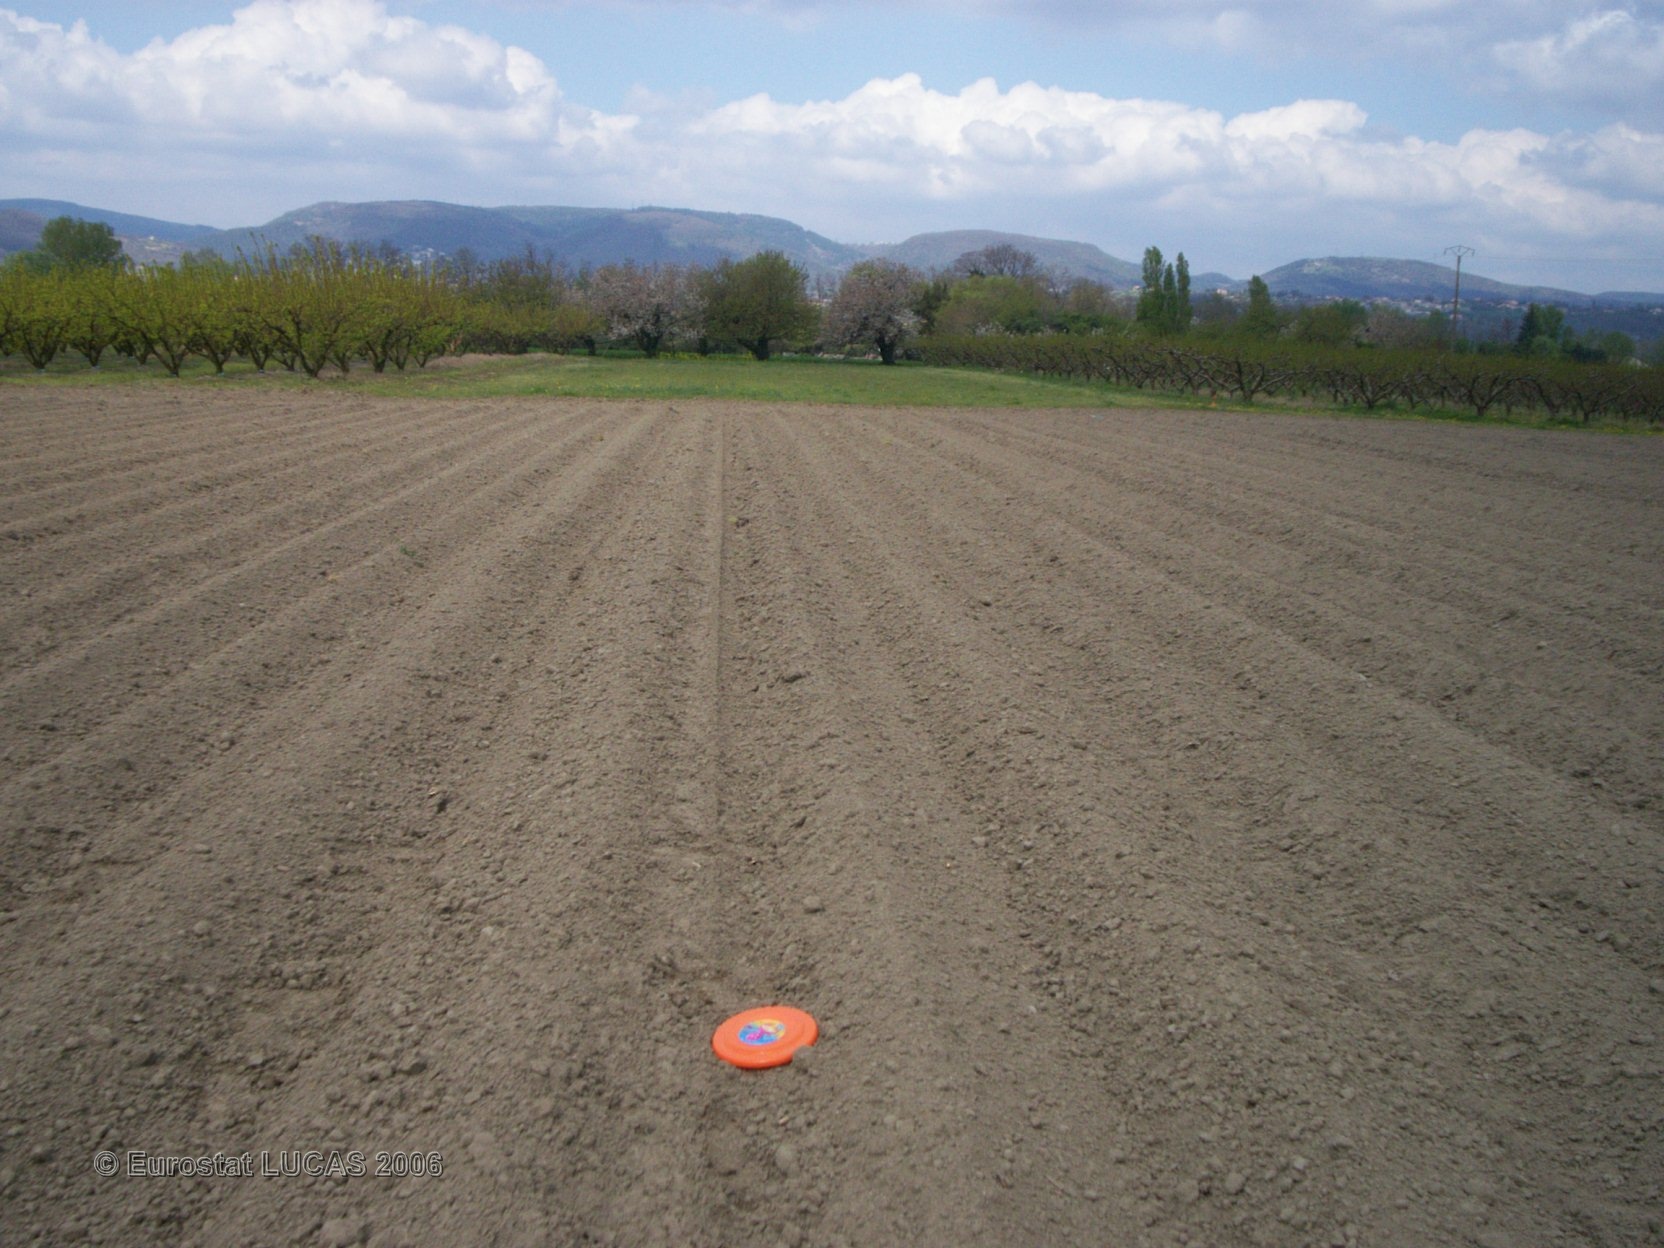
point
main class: Cropland
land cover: Potatoes
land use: Agriculture (excluding fallow land and kitchen gardens)
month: June
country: FR
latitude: 44.8553
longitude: 4.8557
